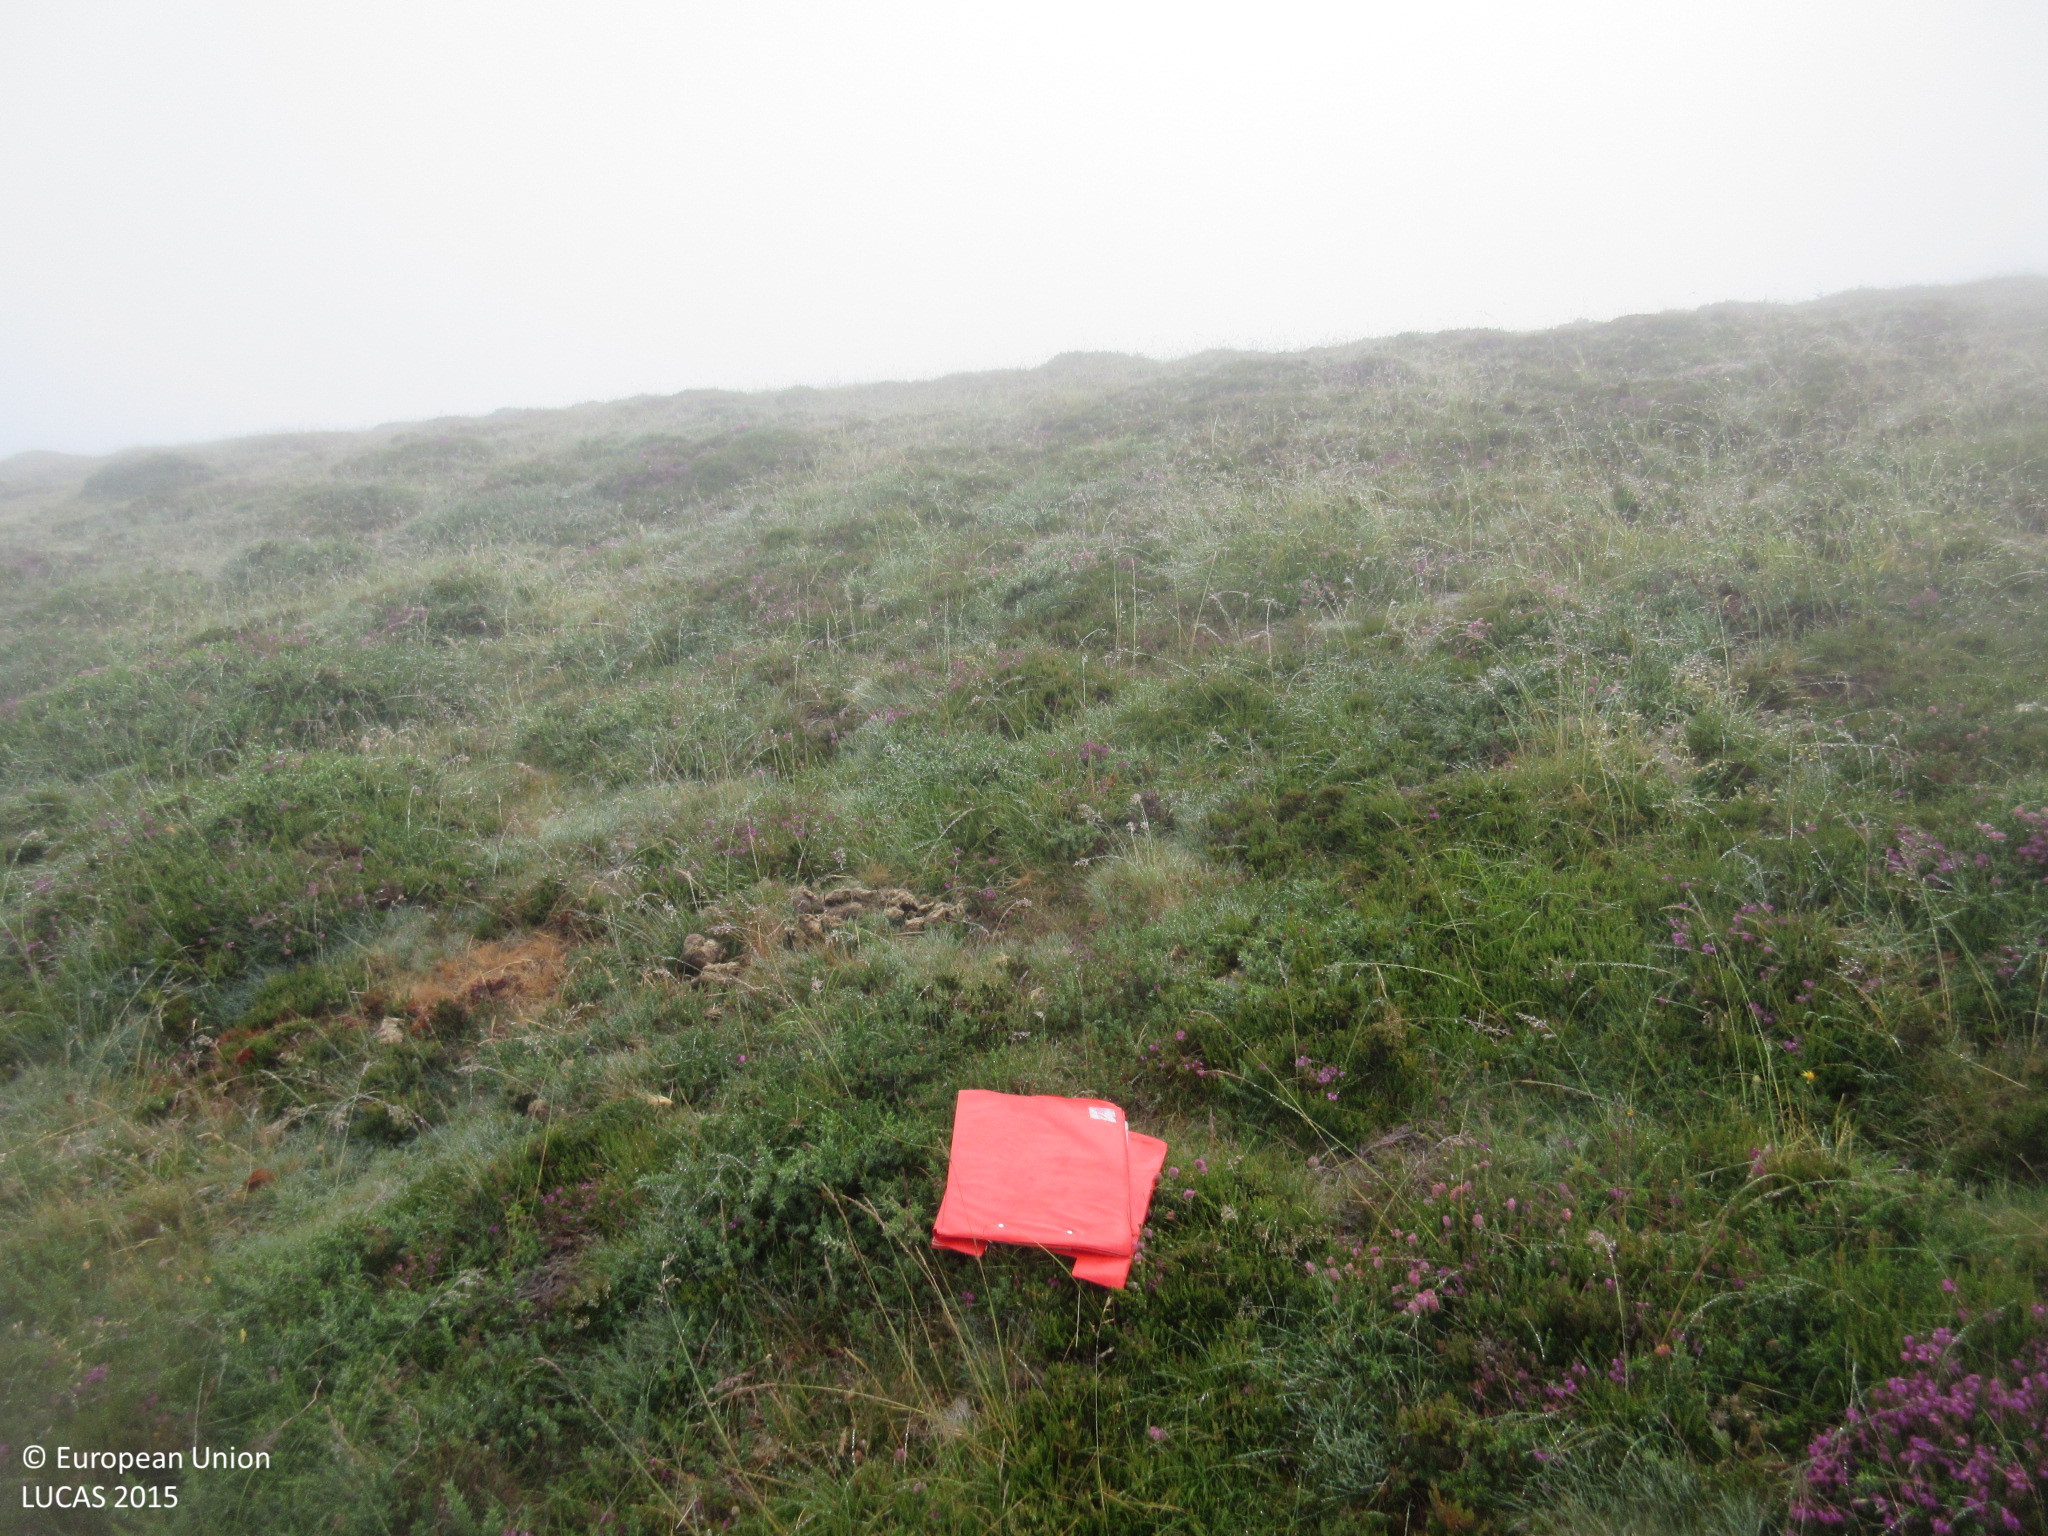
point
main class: Shrubland
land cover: Shrubland without tree cover
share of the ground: 50 - 75 %
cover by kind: shrubs 60 %, herbaceous plants 40 %
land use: Agriculture (excluding fallow land and kitchen gardens)
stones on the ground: 10 - 25 %
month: July
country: ES
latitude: 43.1457
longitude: -3.5553
